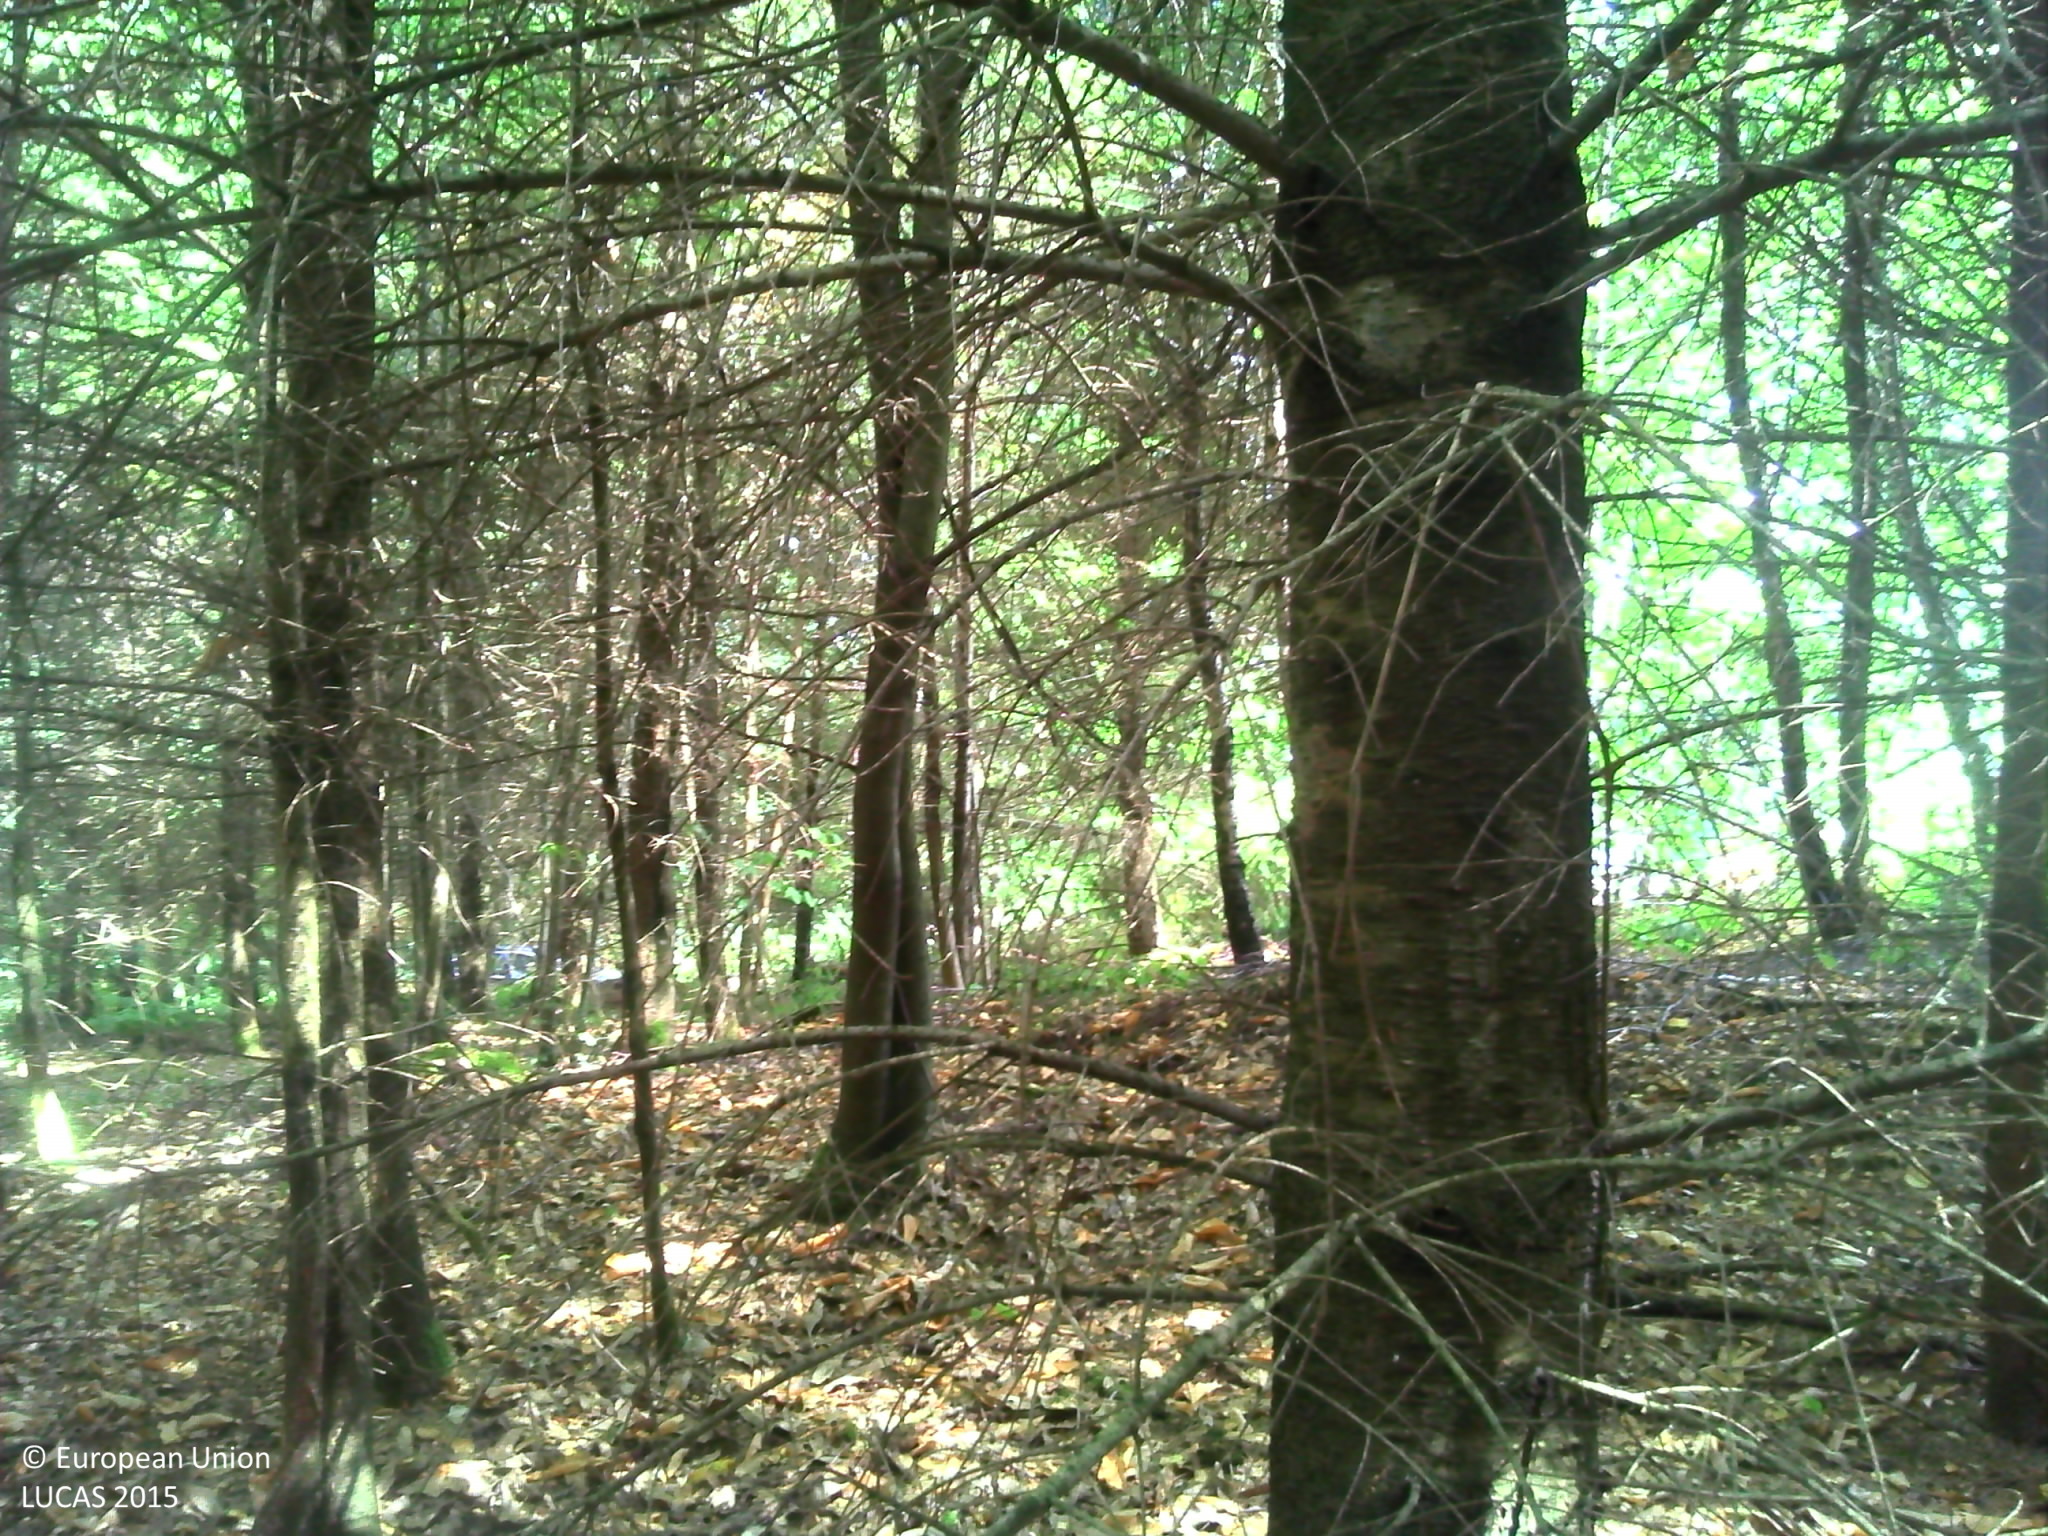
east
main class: Woodland
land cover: Spruce dominated coniferous woodland
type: exotic forest
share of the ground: > 75 %
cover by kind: coniferous forest trees 90 %, shrubs 5 %, herbaceous plants 5 %
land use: Forestry
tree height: > 5 m
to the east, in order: Spruce dominated coniferous woodland; Ditches and canals; Tracks; Spruce dominated coniferous woodland; Fences; Grassland without tree/shrub cover; Fences; Lines of trees; Grass margins; Paved roads, cycling and walking lanes; Grass margins; Fences; Broadleaved woodland; Grassland without tree/shrub cover; Tracks; Broadleaved woodland; Grassland without tree/shrub cover
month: July
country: FR
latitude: 46.0437
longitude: 4.4326
